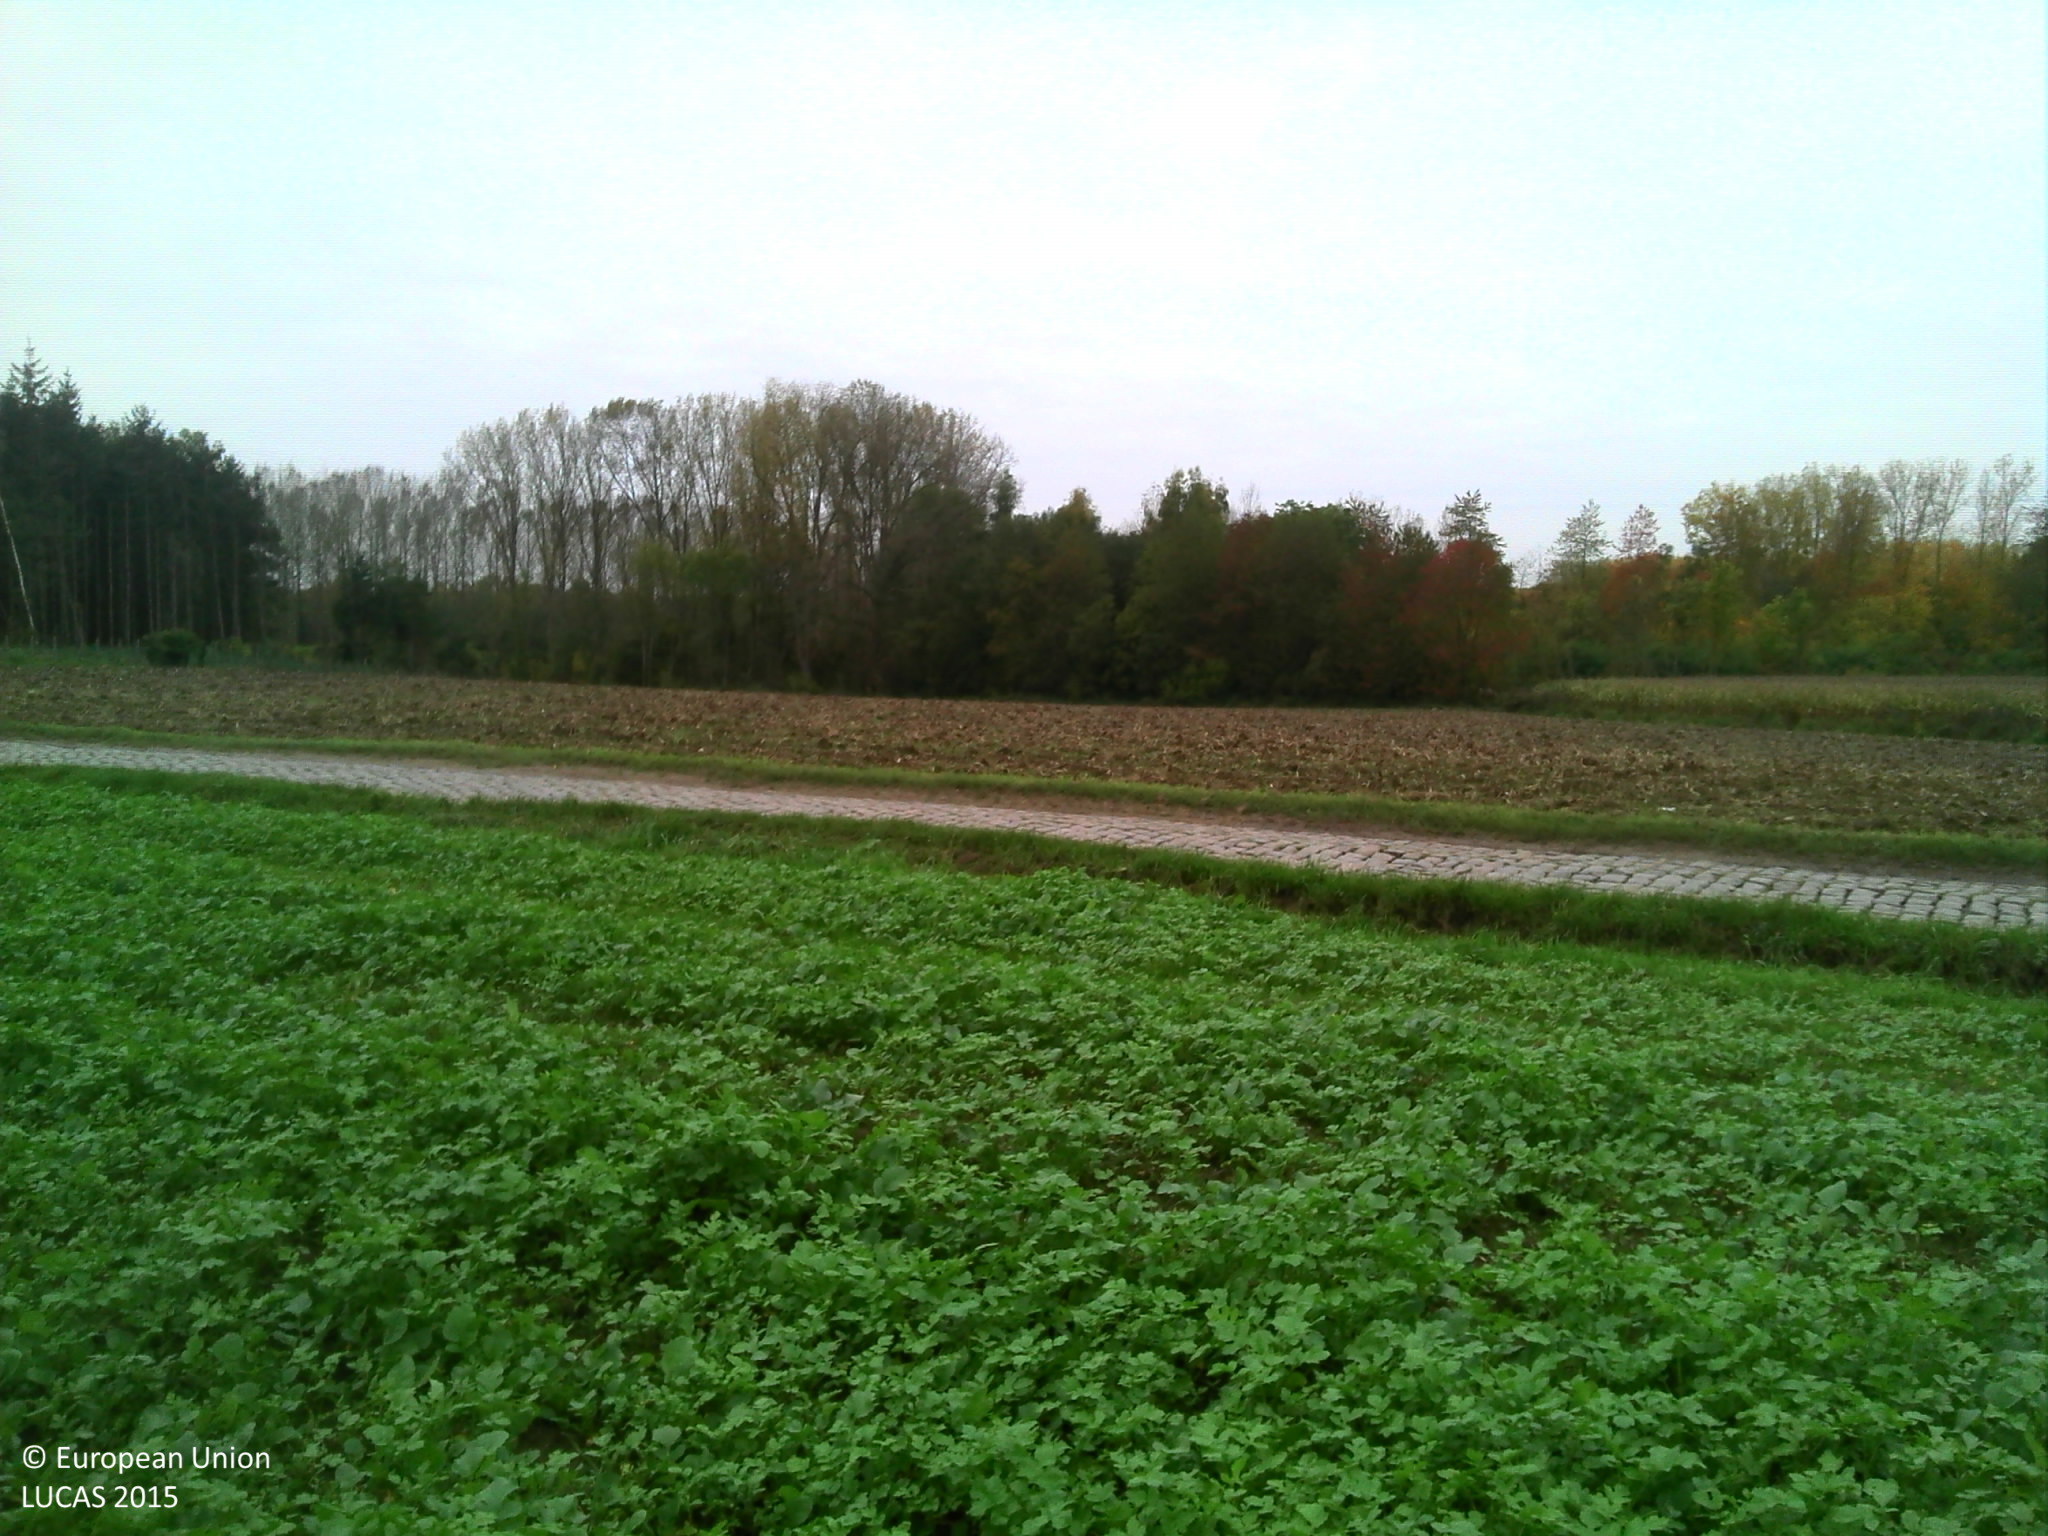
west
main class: Cropland
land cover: Other fibre and oleaginous crops
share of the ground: > 75 %
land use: Agriculture (excluding fallow land and kitchen gardens)
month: October
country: BE
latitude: 50.8980
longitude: 4.1223
